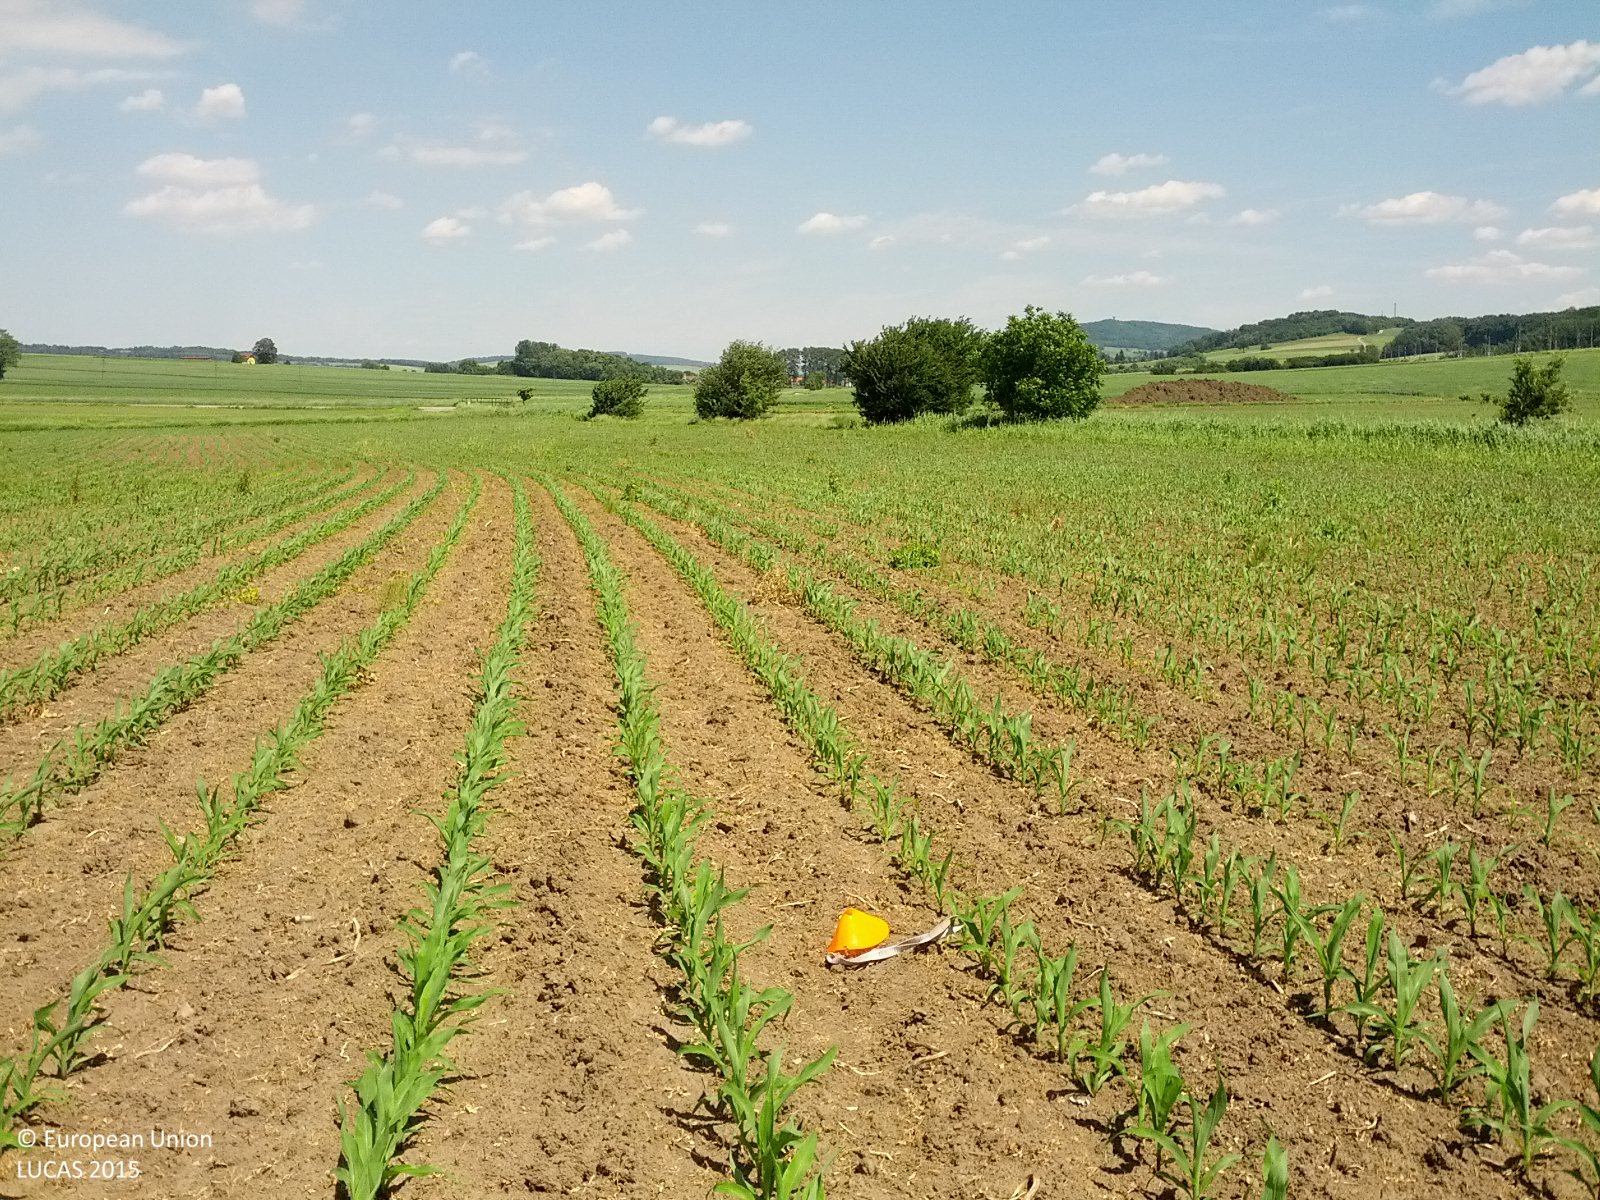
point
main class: Cropland
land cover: Maize
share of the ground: < 10 %
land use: Agriculture (excluding fallow land and kitchen gardens)
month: June
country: AT
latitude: 48.1942
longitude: 15.8553
